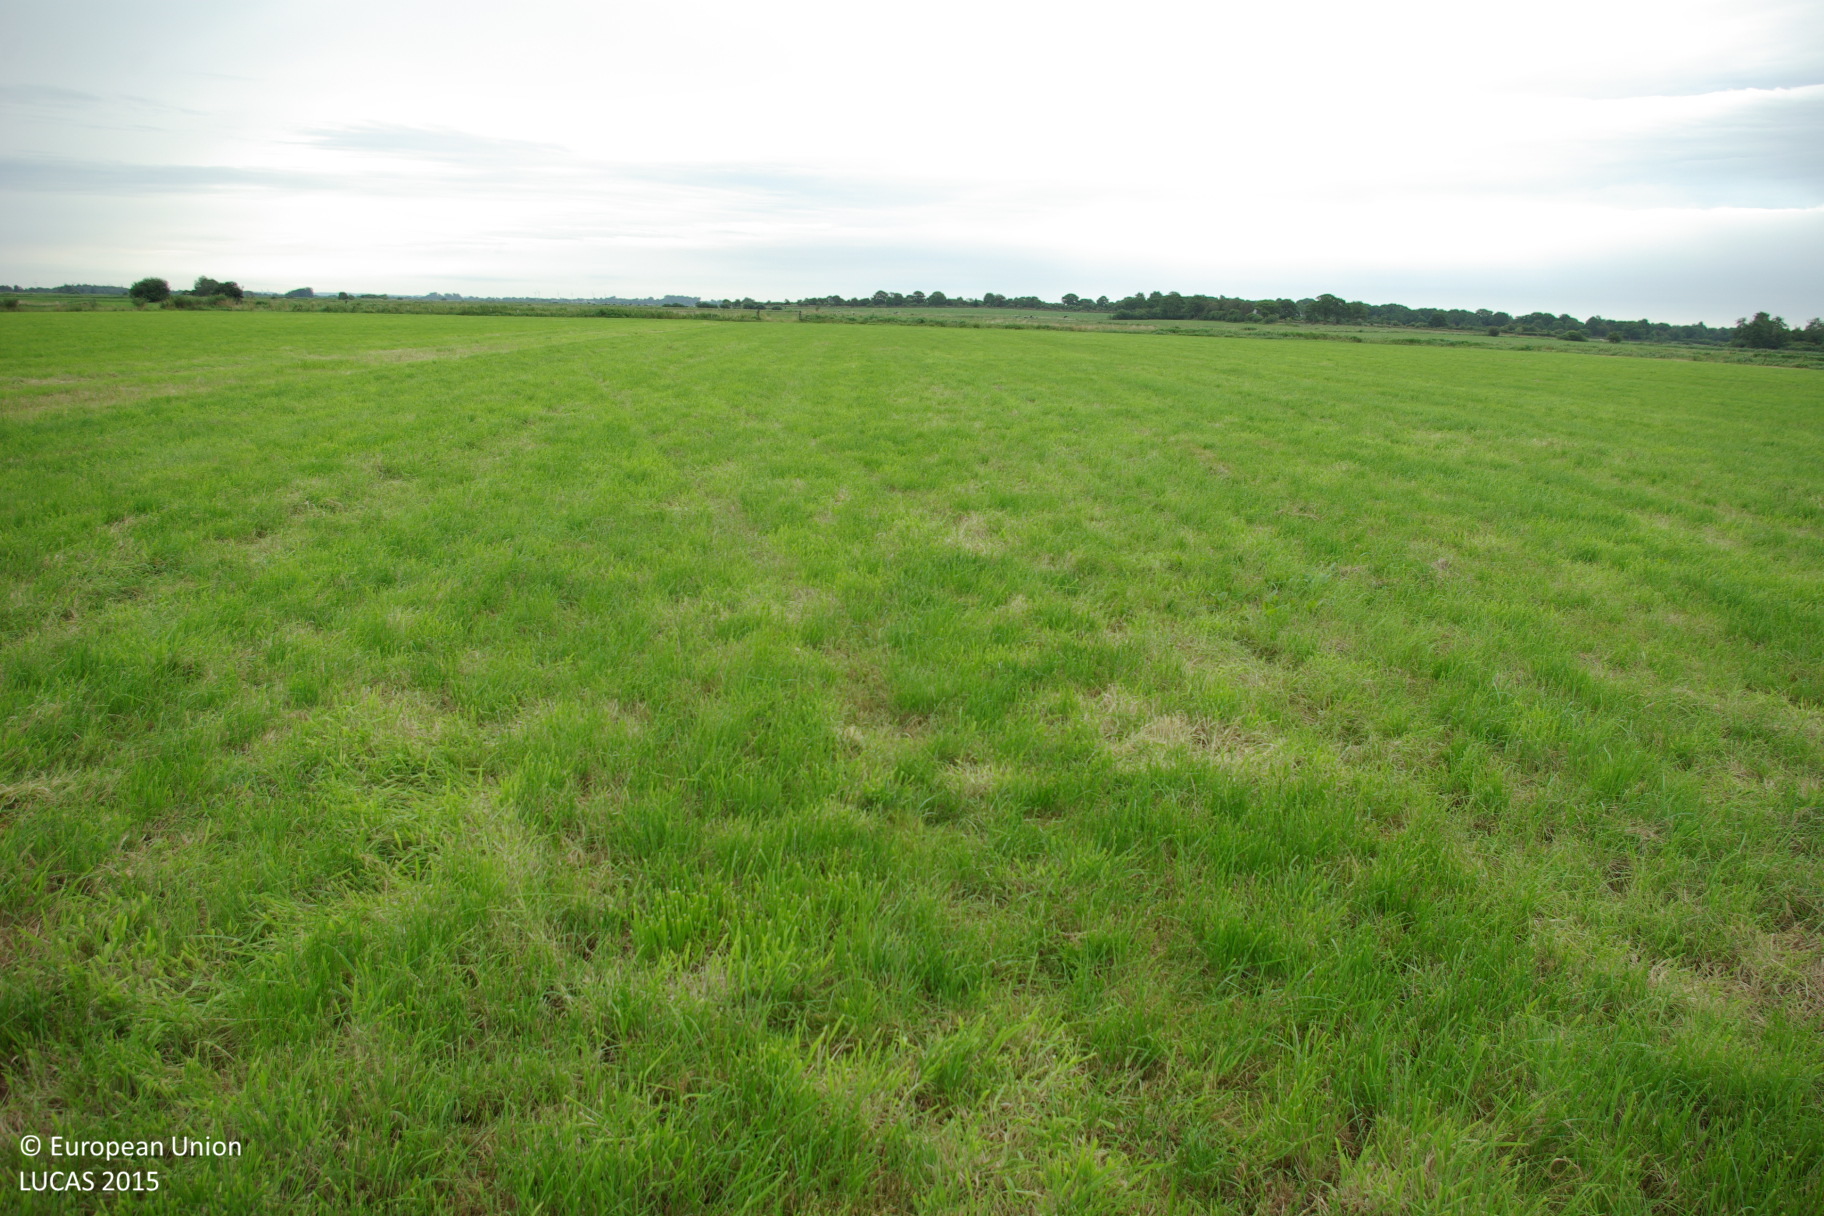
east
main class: Grassland
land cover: Grassland without tree/shrub cover
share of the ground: > 75 %
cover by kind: herbaceous plants 100 %
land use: Agriculture (excluding fallow land and kitchen gardens)
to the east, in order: Grassland without tree/shrub cover; Shruby margins; Ditches and canals; Spontaneously vegetated surfaces; Grassland without tree/shrub cover; Paved roads, cycling and walking lanes; Grass margins; Shruby margins; Ditches and canals; Grassland without tree/shrub cover
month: August
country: DE
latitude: 54.3345
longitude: 9.3084
